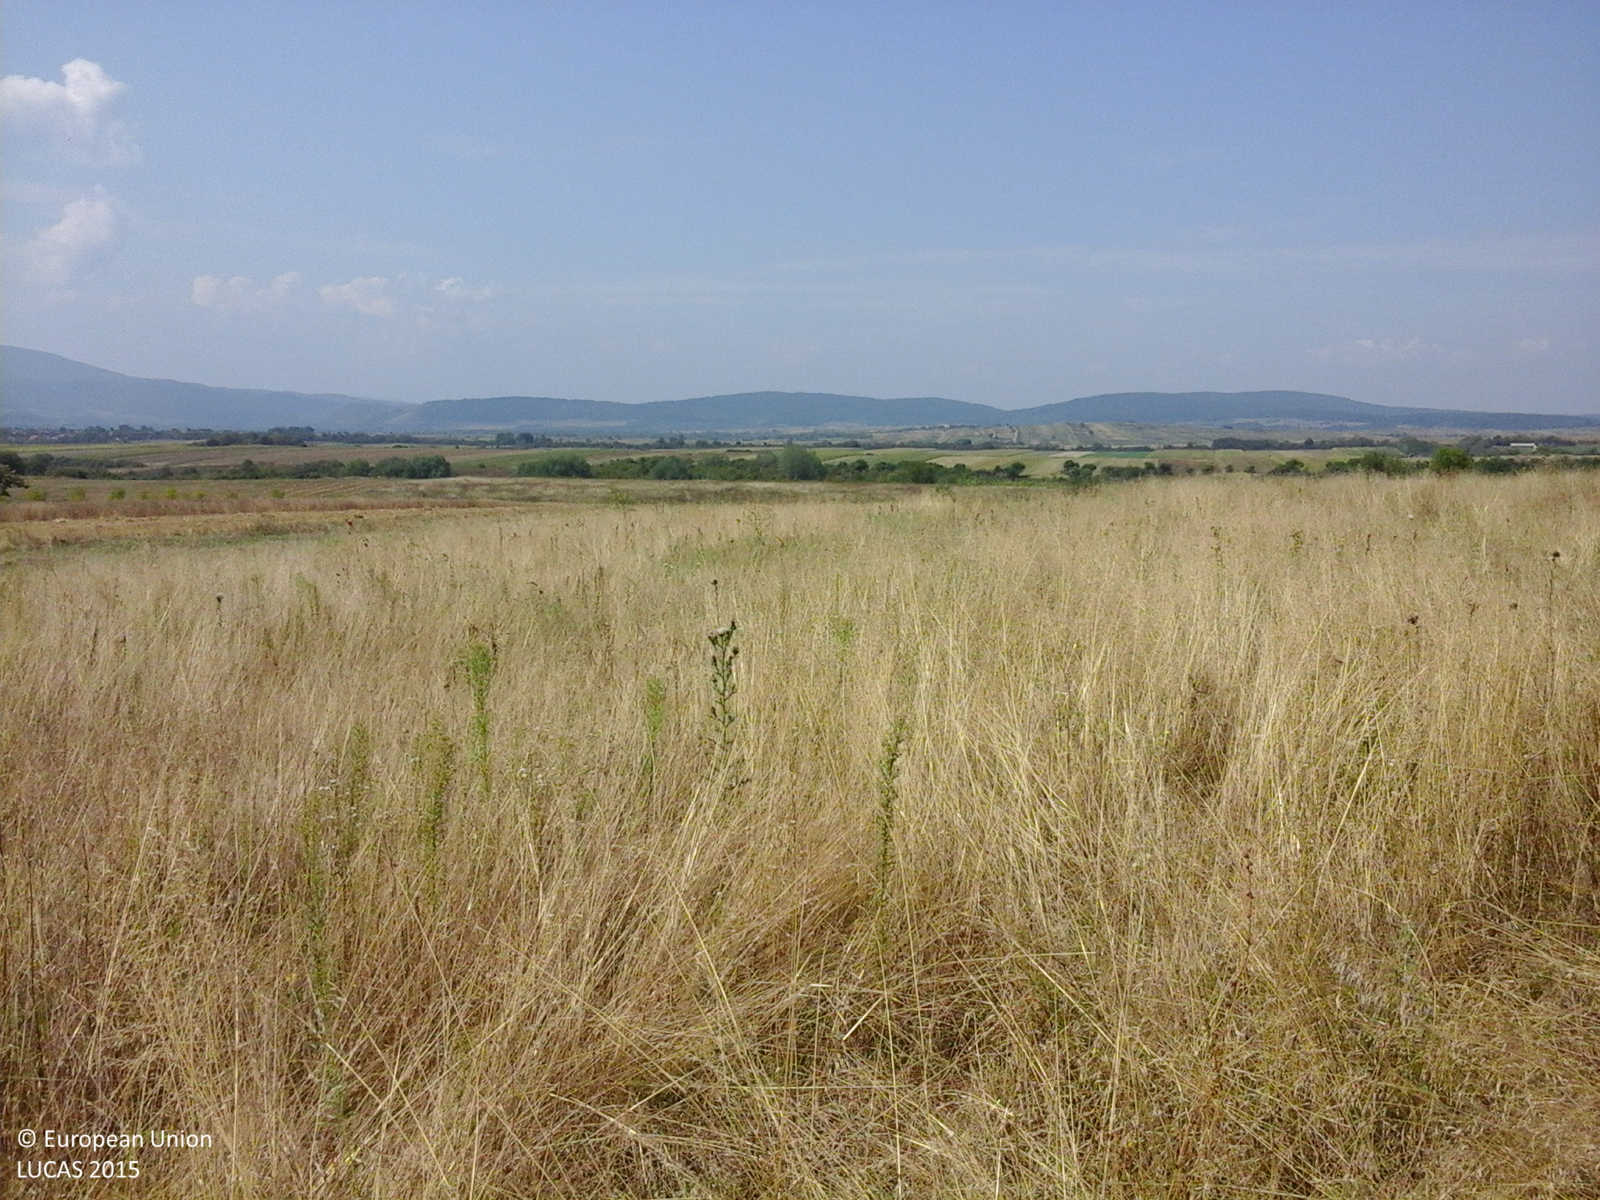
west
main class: Grassland
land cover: Grassland without tree/shrub cover
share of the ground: > 75 %
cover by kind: herbaceous plants 100 %
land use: Agriculture (excluding fallow land and kitchen gardens)
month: August
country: RO
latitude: 46.3335
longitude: 22.2714
